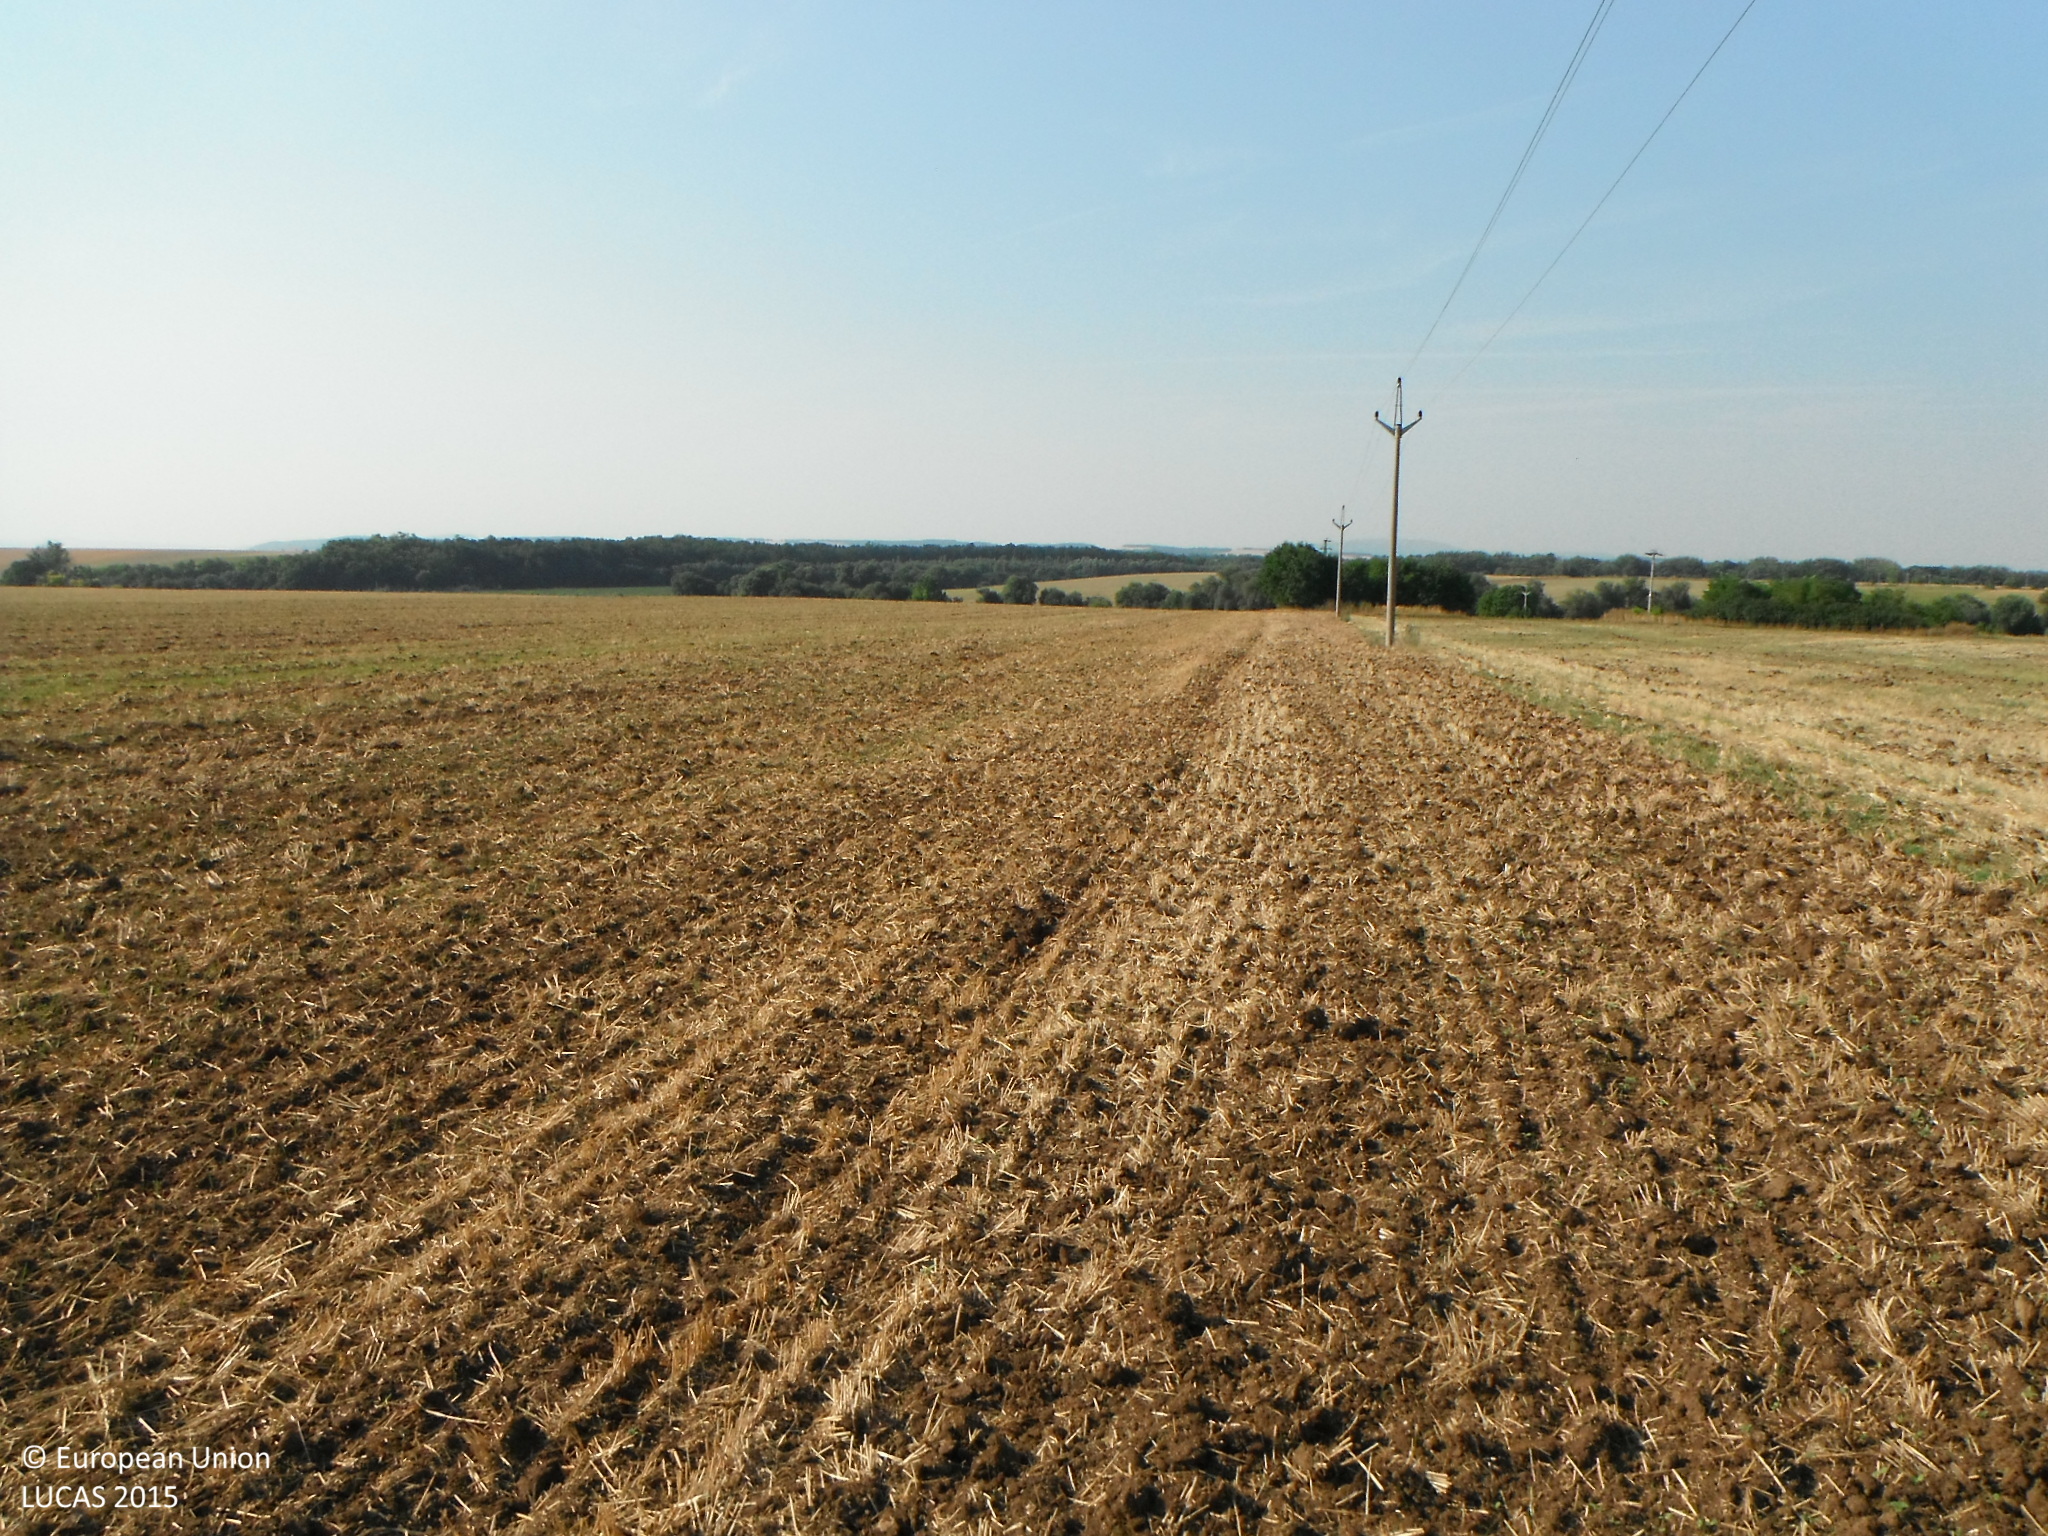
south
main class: Cropland
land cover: Common wheat
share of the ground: < 10 %
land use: Agriculture (excluding fallow land and kitchen gardens)
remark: Harvested field
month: August
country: SK
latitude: 47.9236
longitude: 18.5944
